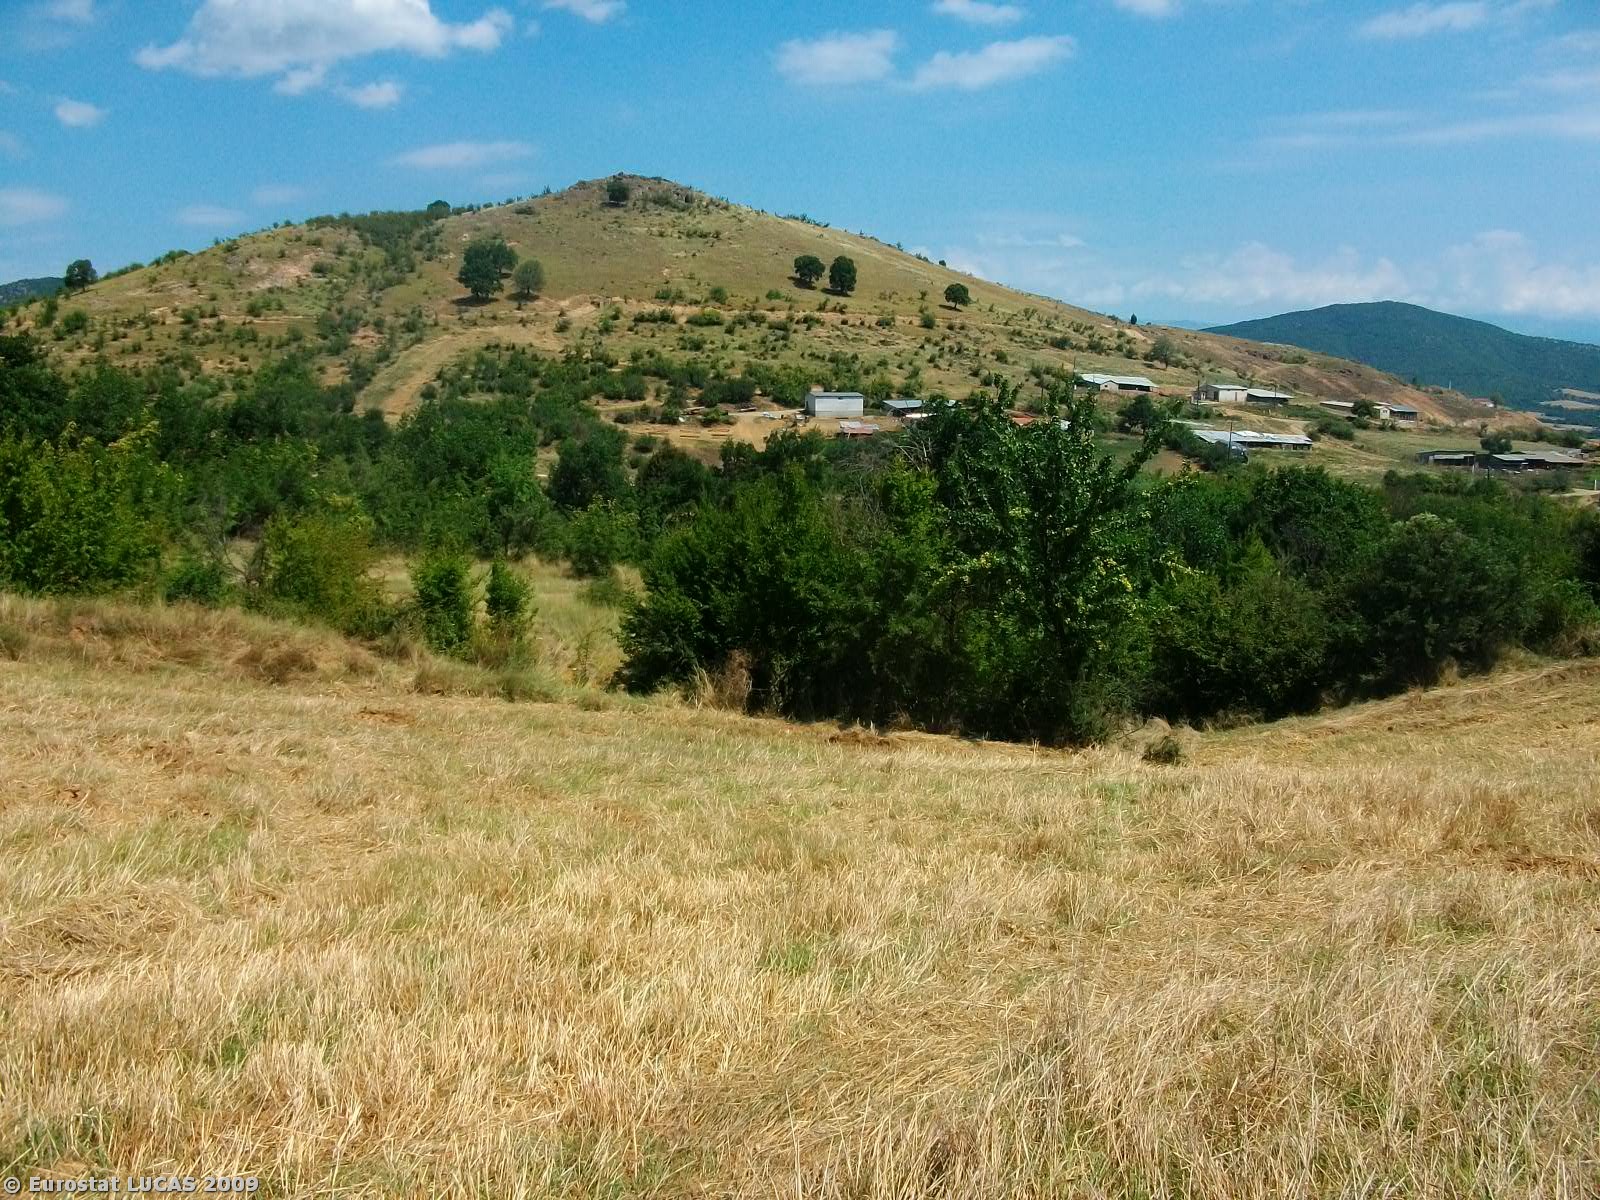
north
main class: Cropland
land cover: Barley
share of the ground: < 10 %
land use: Agriculture (excluding fallow land and kitchen gardens)
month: July
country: GR
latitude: 41.1409
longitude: 22.9635
